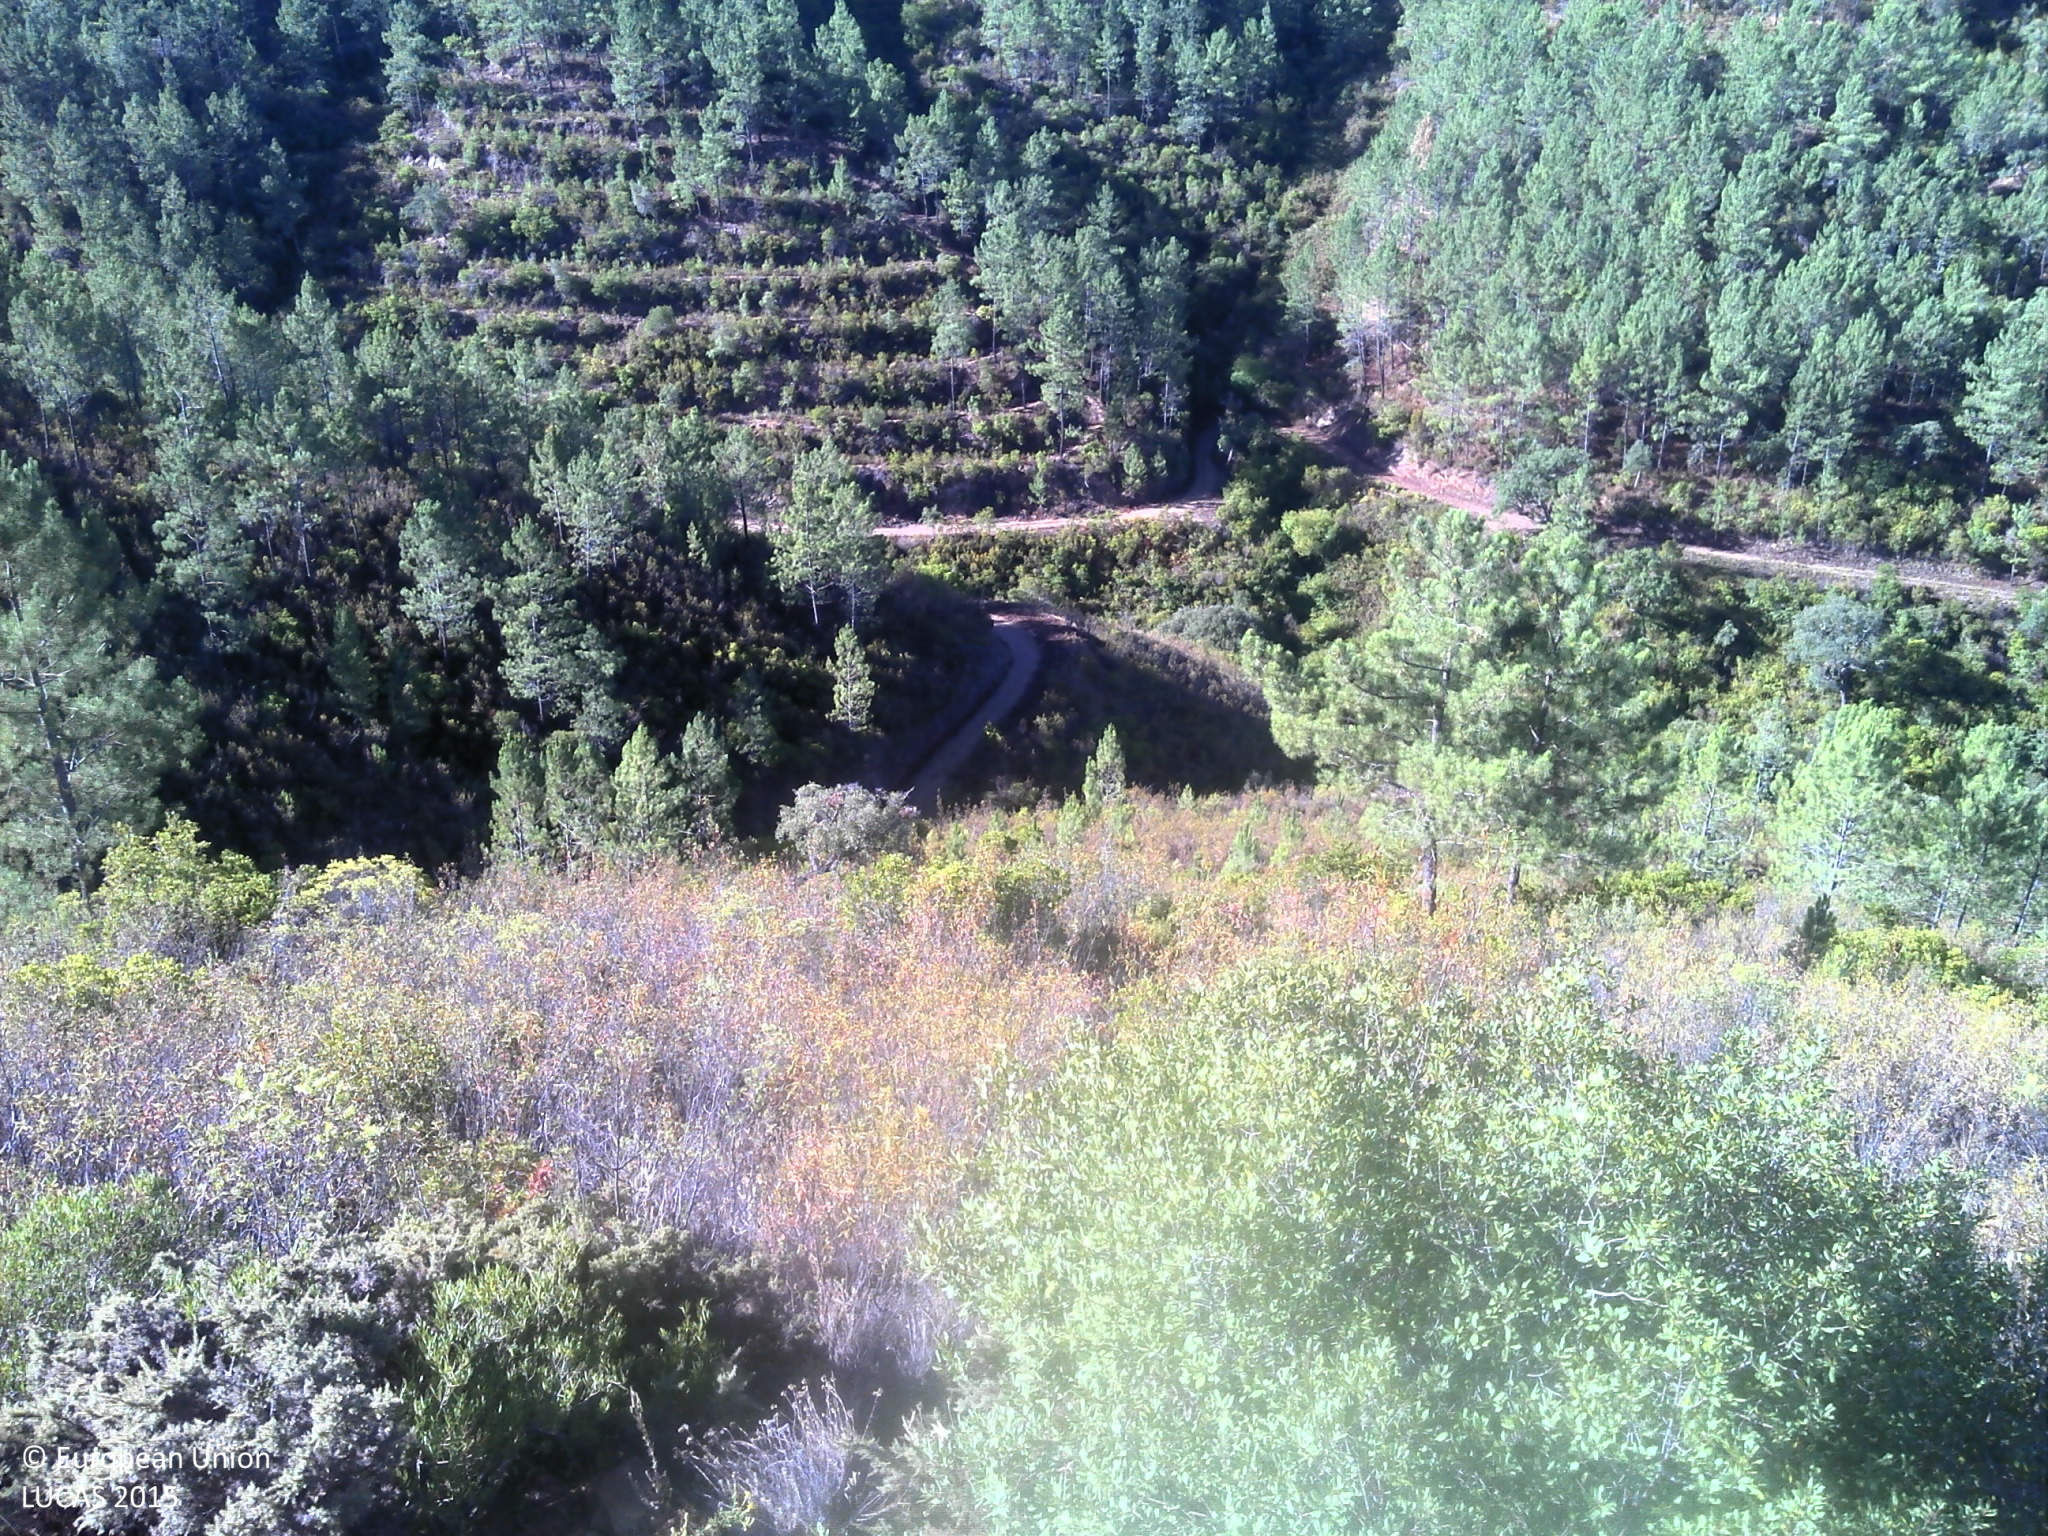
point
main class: Woodland
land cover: Pine dominated coniferous woodland
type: coniferous forest of the mediterranean region
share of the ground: 25 - 50 %
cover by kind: shrubs 55 %, coniferous forest trees 25 %, unconsolidated bare surface 20 %
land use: Forestry
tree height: > 5 m
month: September
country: PT
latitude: 37.3014
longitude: -8.4268
